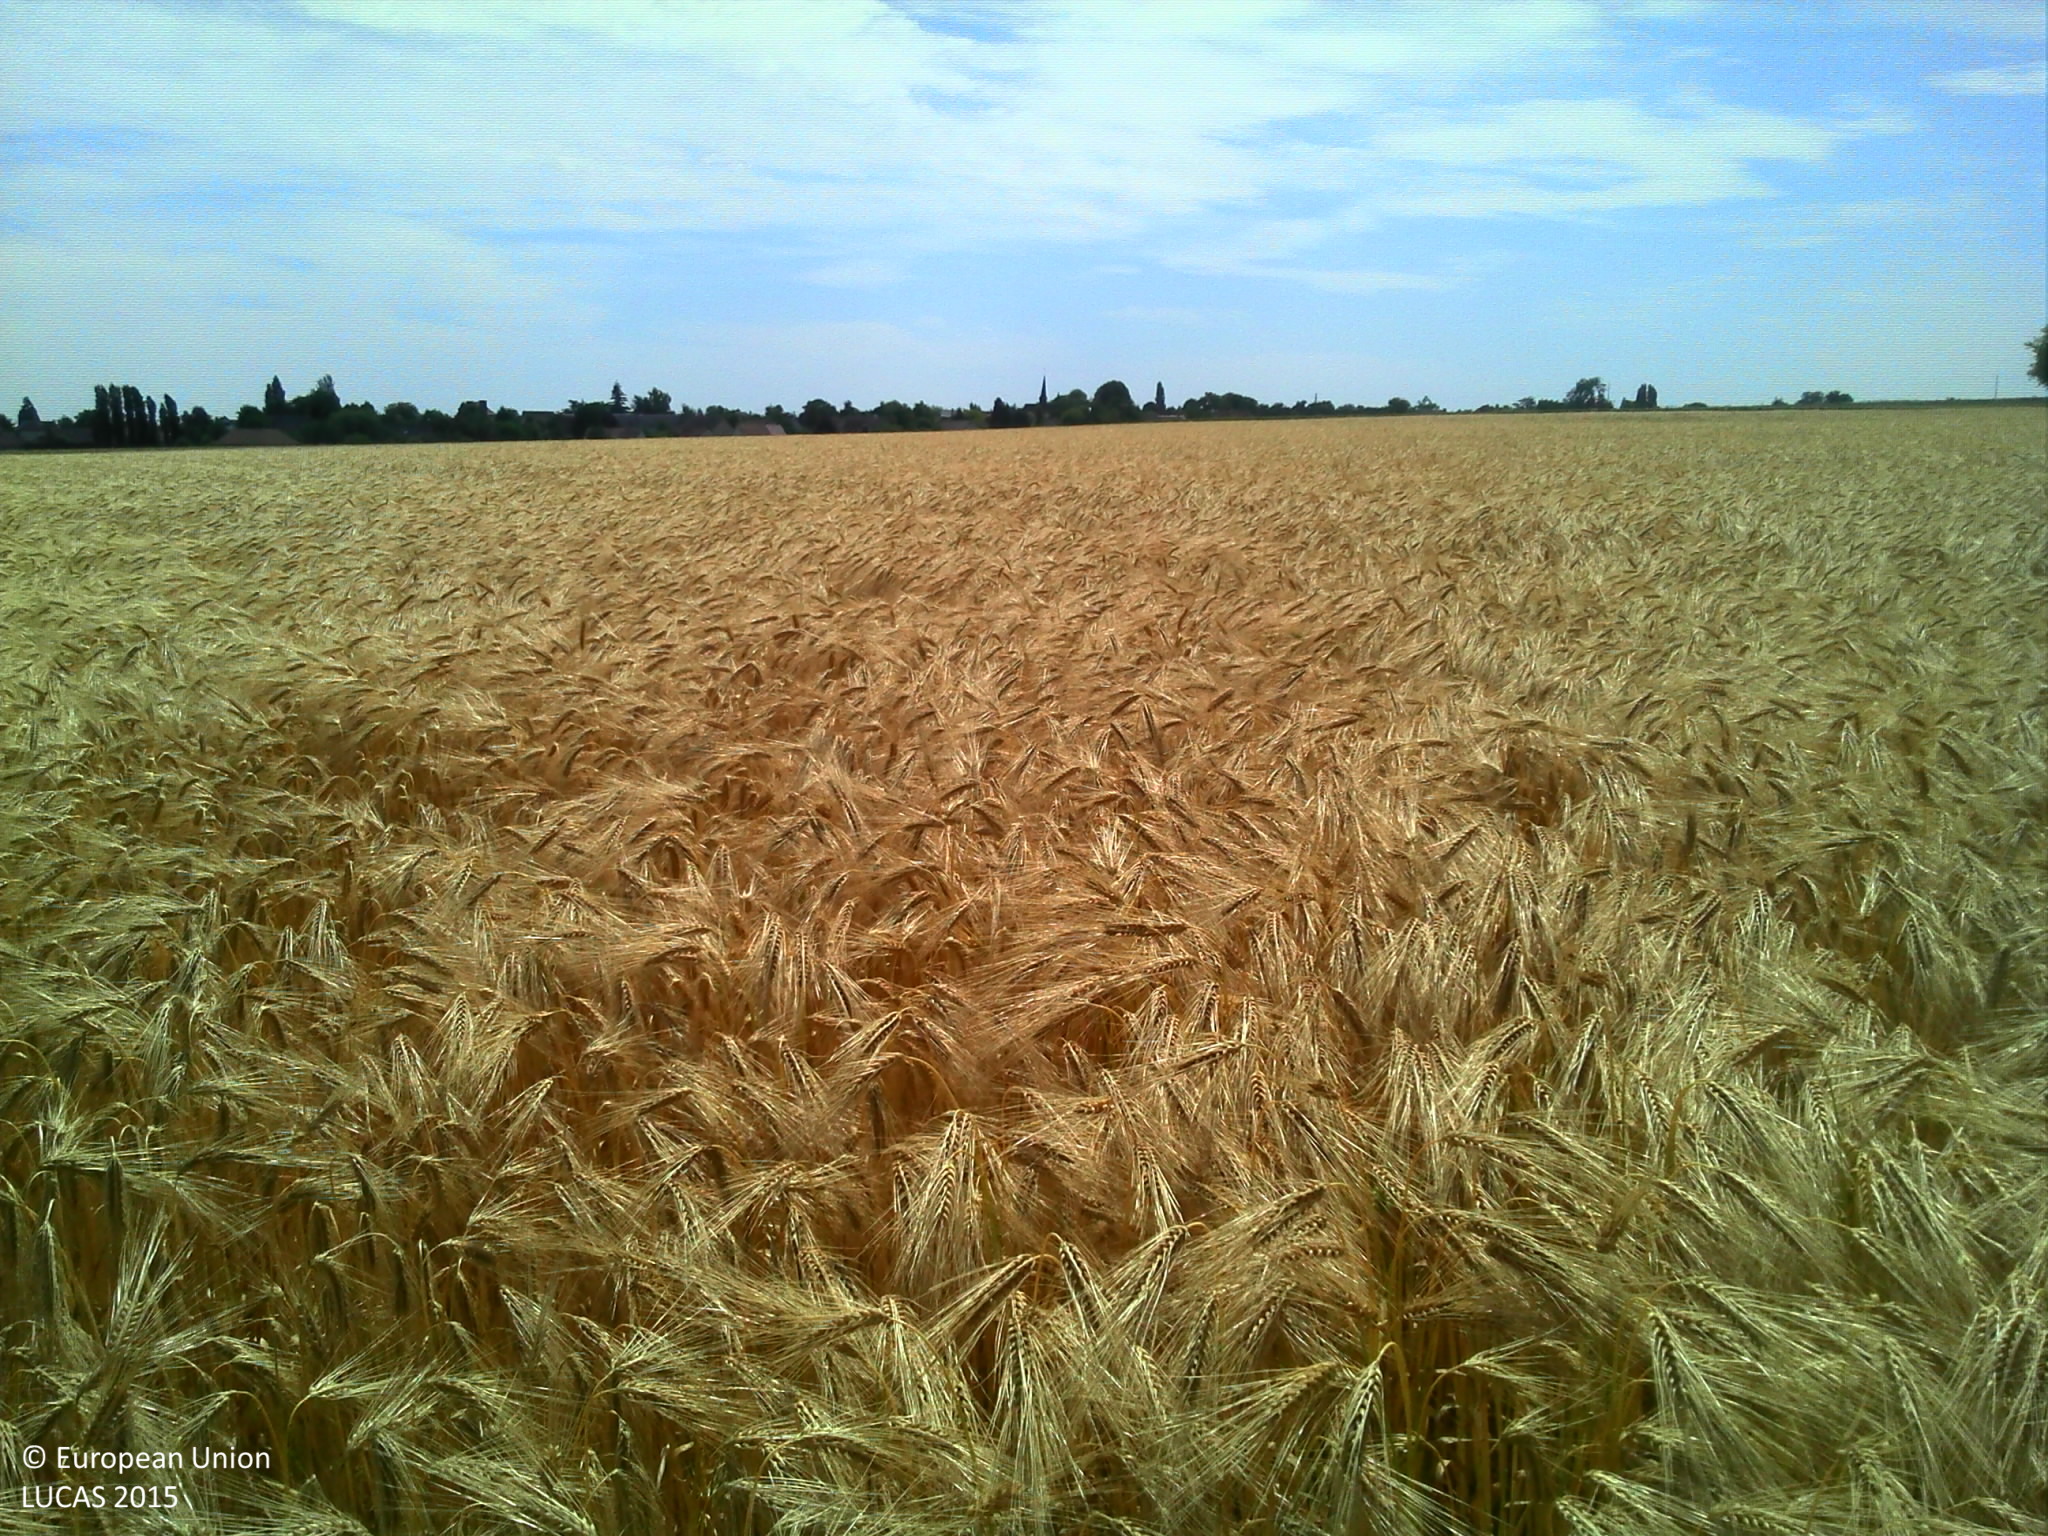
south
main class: Cropland
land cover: Barley
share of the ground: > 75 %
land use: Agriculture (excluding fallow land and kitchen gardens)
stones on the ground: 10 - 25 %
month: June
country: FR
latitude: 49.1017
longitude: 1.2002
